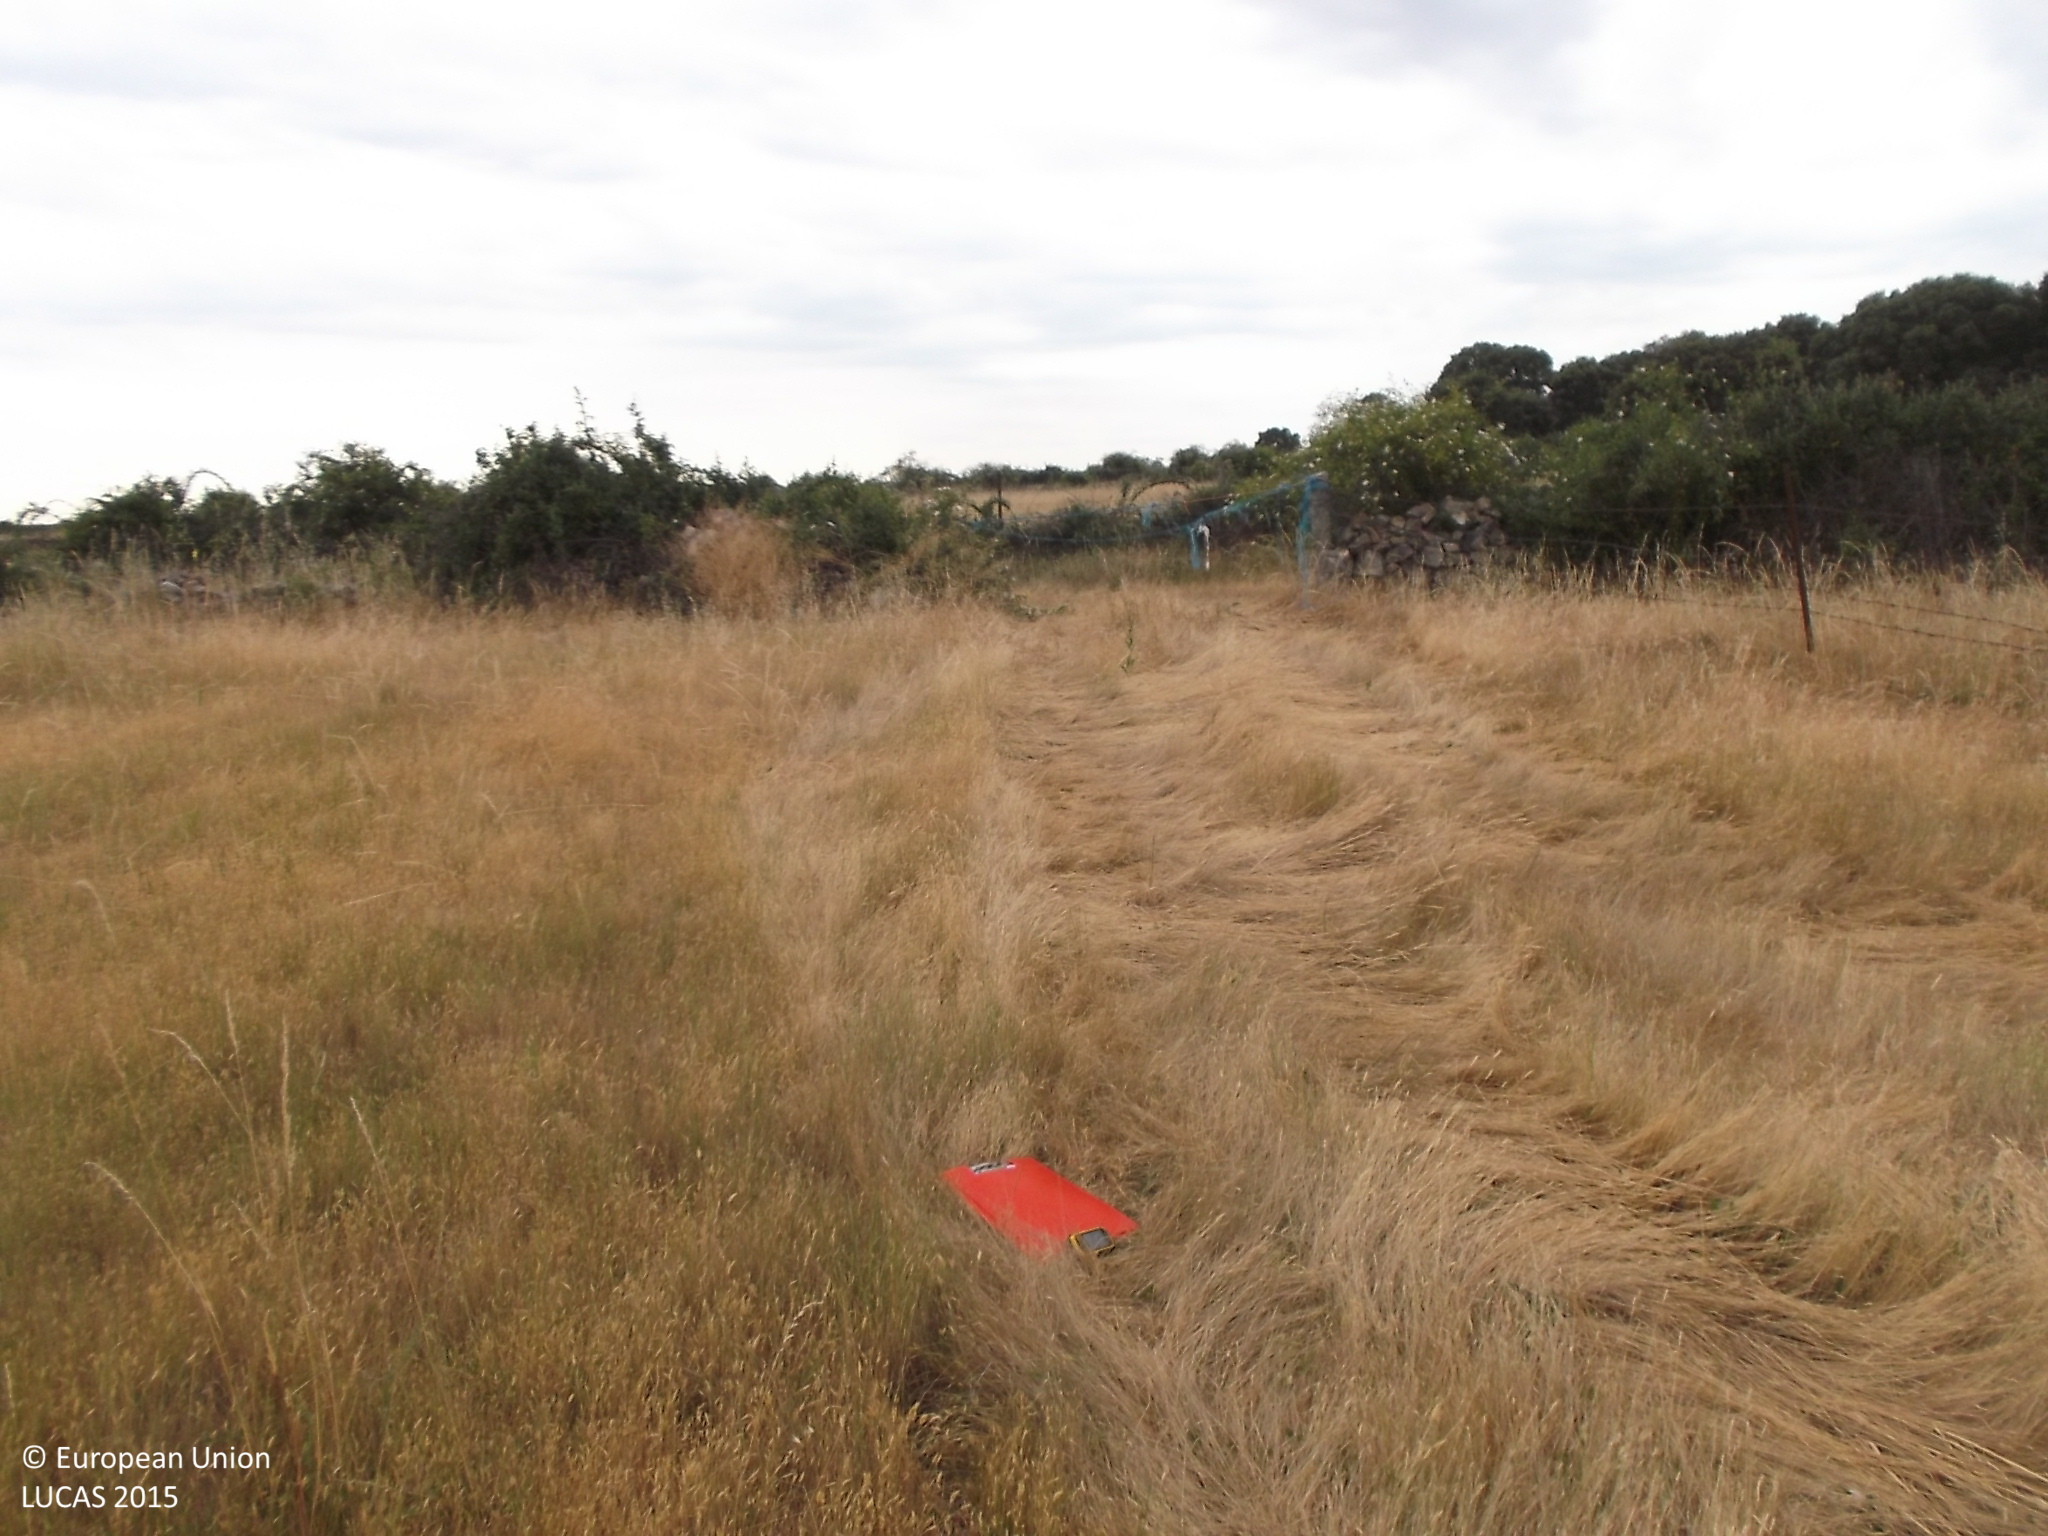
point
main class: Grassland
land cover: Grassland without tree/shrub cover
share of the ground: > 75 %
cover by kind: herbaceous plants 100 %
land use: Agriculture (excluding fallow land and kitchen gardens)
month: June
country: ES
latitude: 40.7978
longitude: -6.3624
